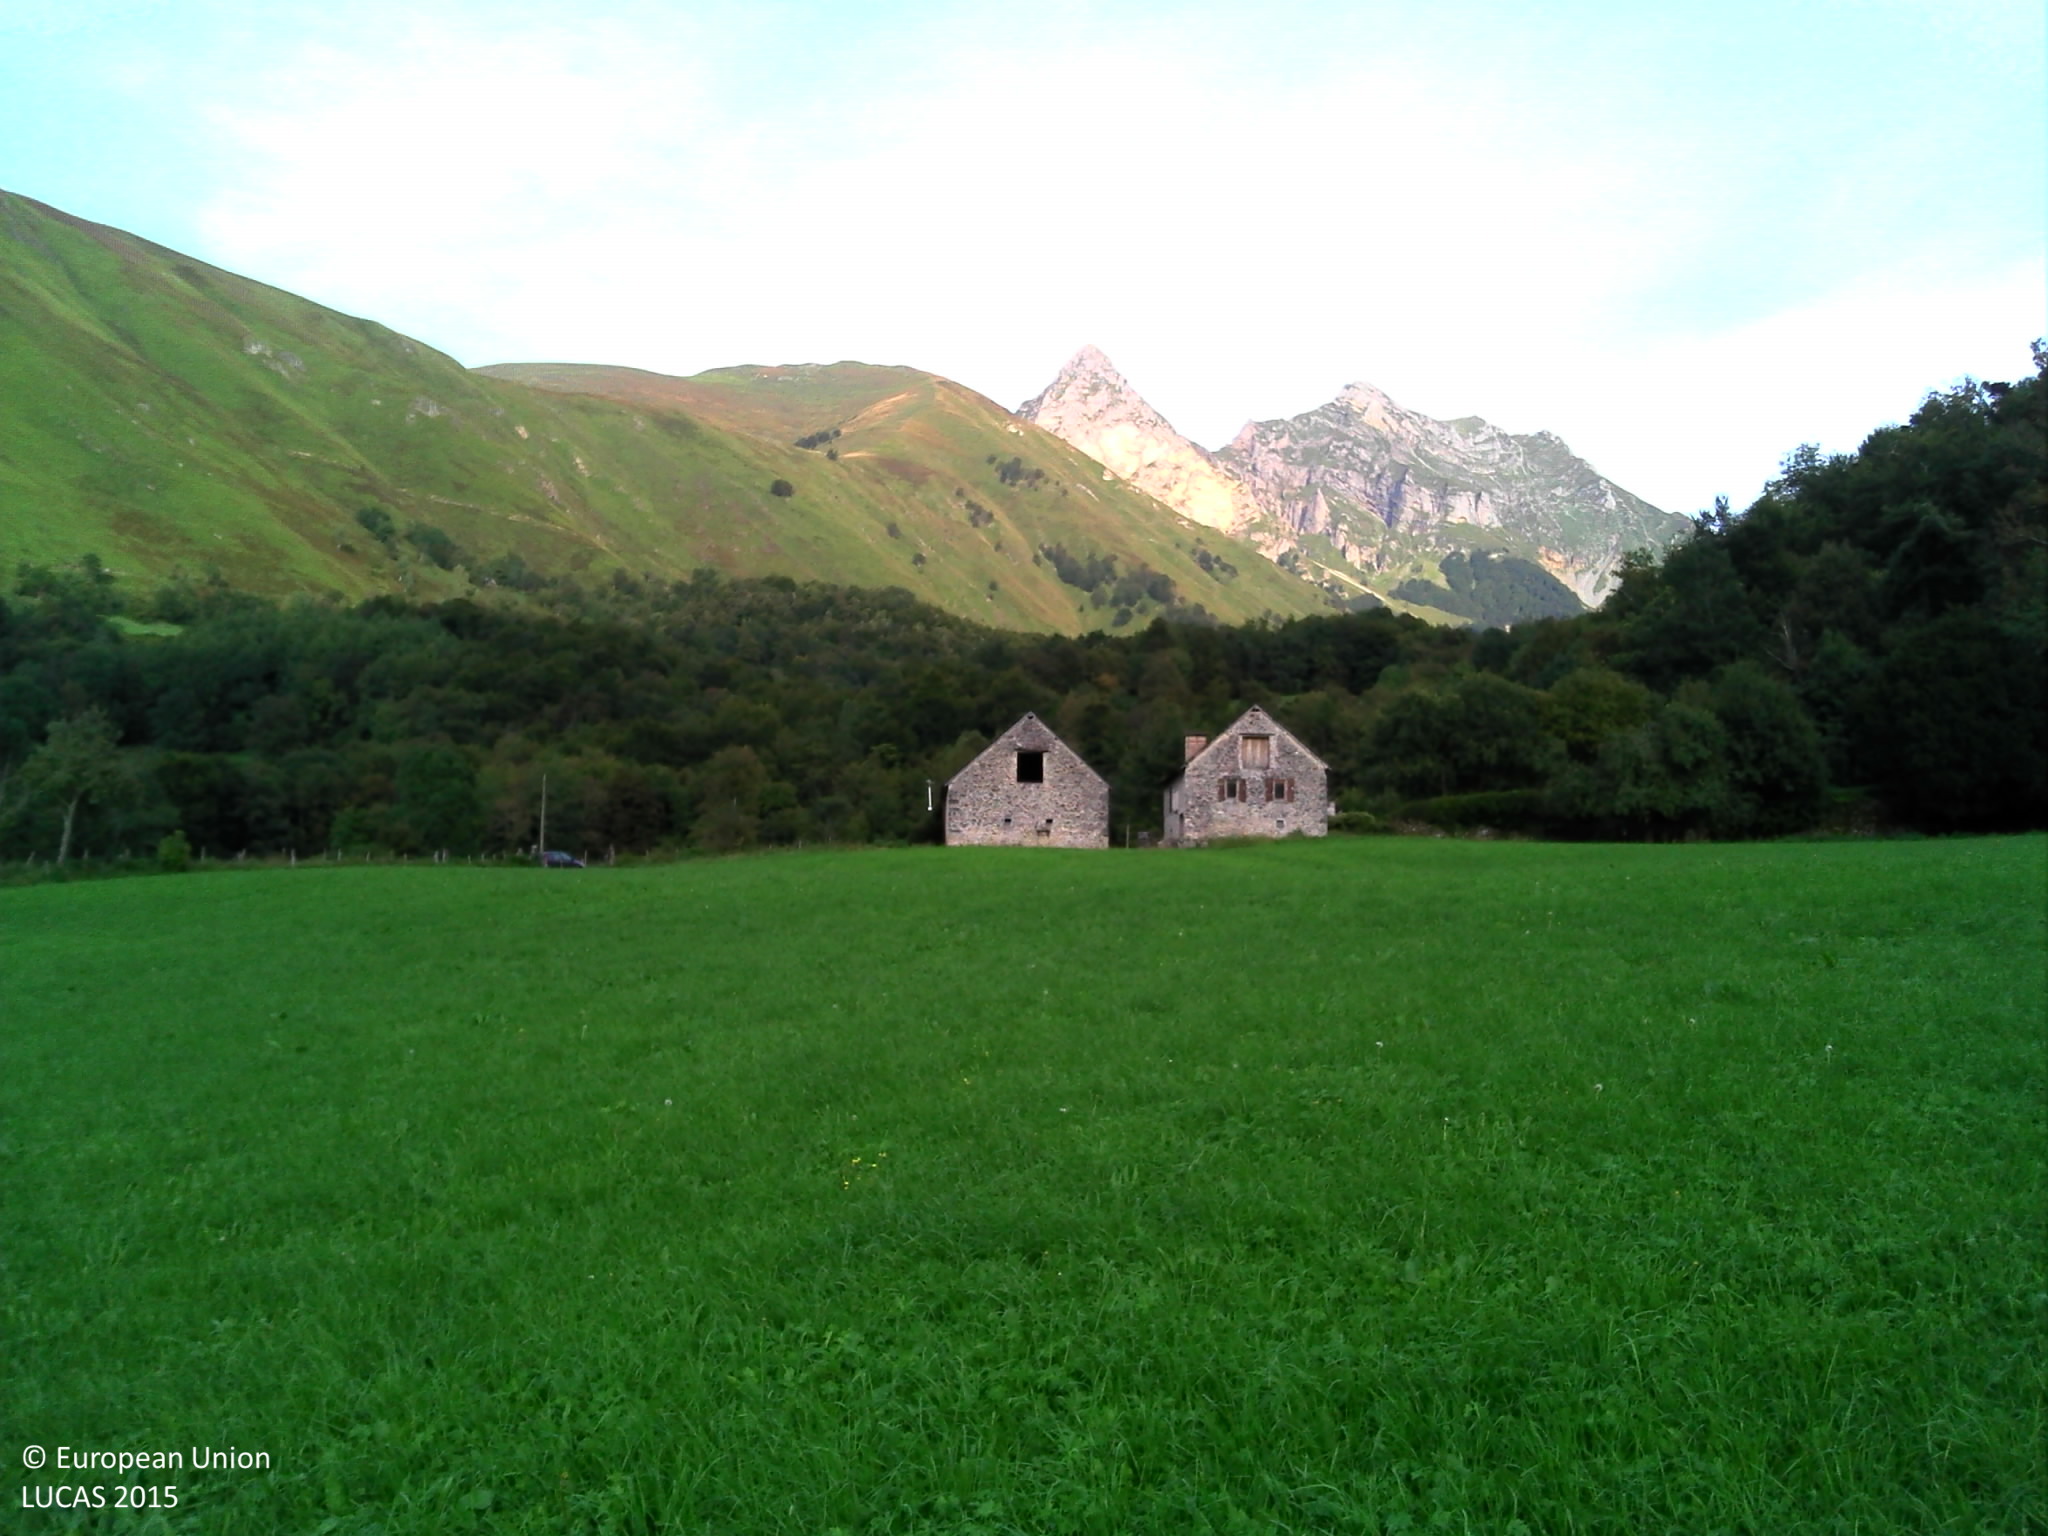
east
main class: Grassland
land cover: Grassland without tree/shrub cover
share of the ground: > 75 %
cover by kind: herbaceous plants 100 %
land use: Agriculture (excluding fallow land and kitchen gardens)
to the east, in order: Grassland without tree/shrub cover; Artificial constructions in urban areas; Grassland without tree/shrub cover; Electric lines; Grassland without tree/shrub cover; Tracks; Managed hedges; Grassland without tree/shrub cover
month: September
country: FR
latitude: 42.9709
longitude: -0.5873
